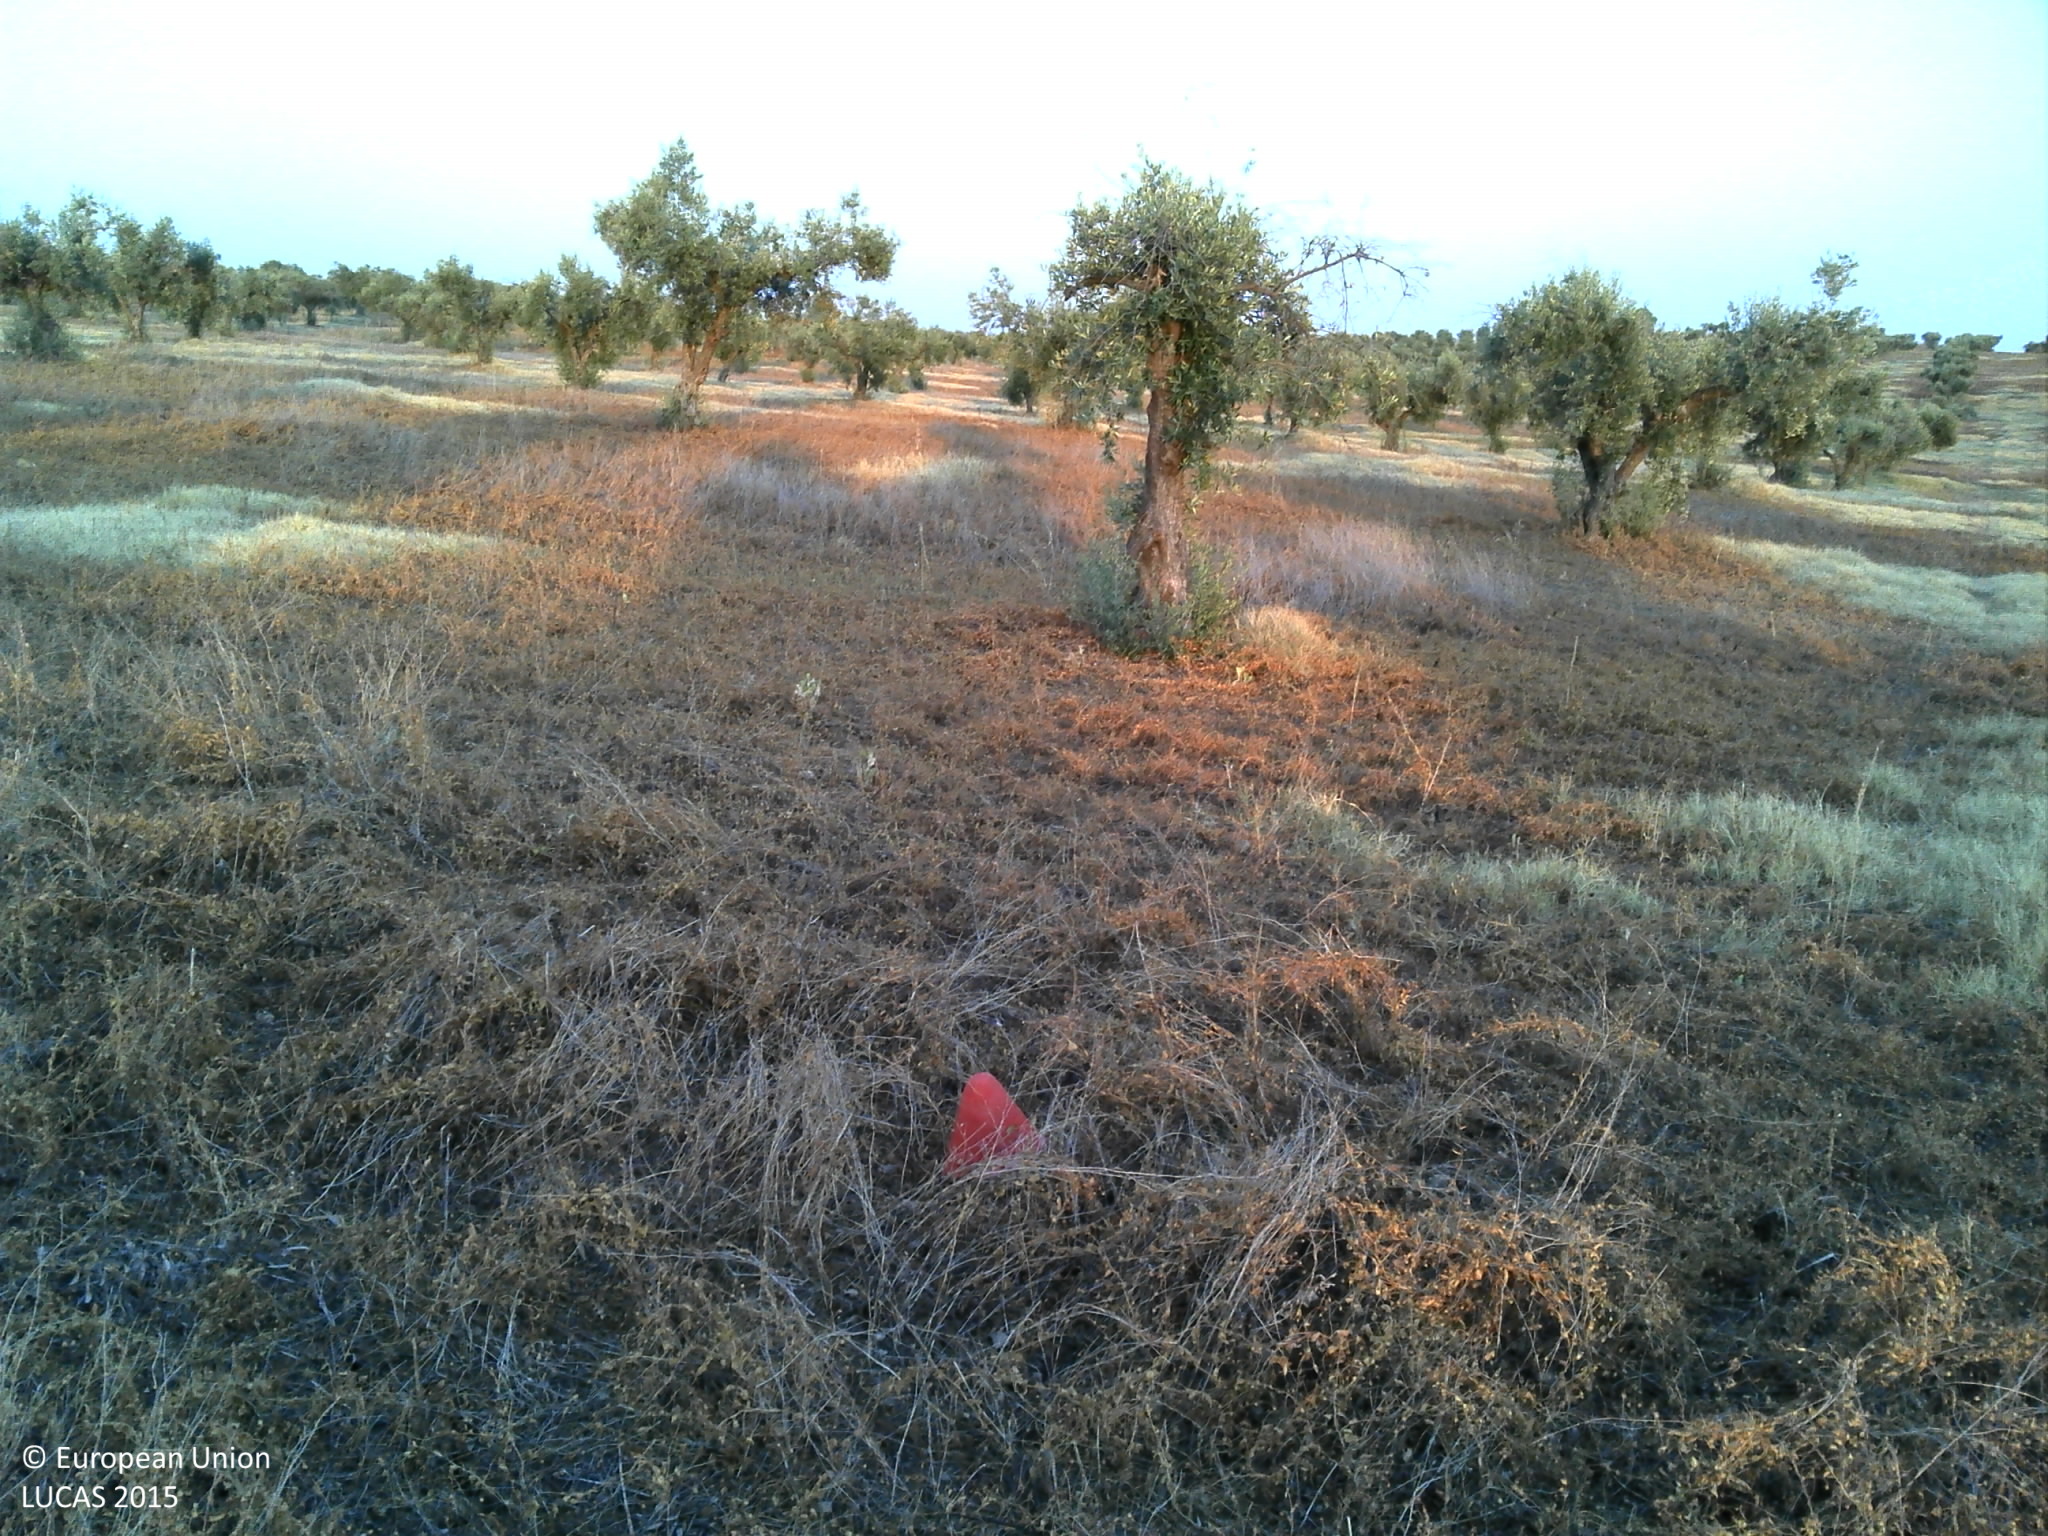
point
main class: Cropland
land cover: Olive groves
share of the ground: 25 - 50 %
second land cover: Grassland without tree/shrub cover
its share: 50 - 75 %
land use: Agriculture (excluding fallow land and kitchen gardens)
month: June
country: PT
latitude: 38.2891
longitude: -7.3188
